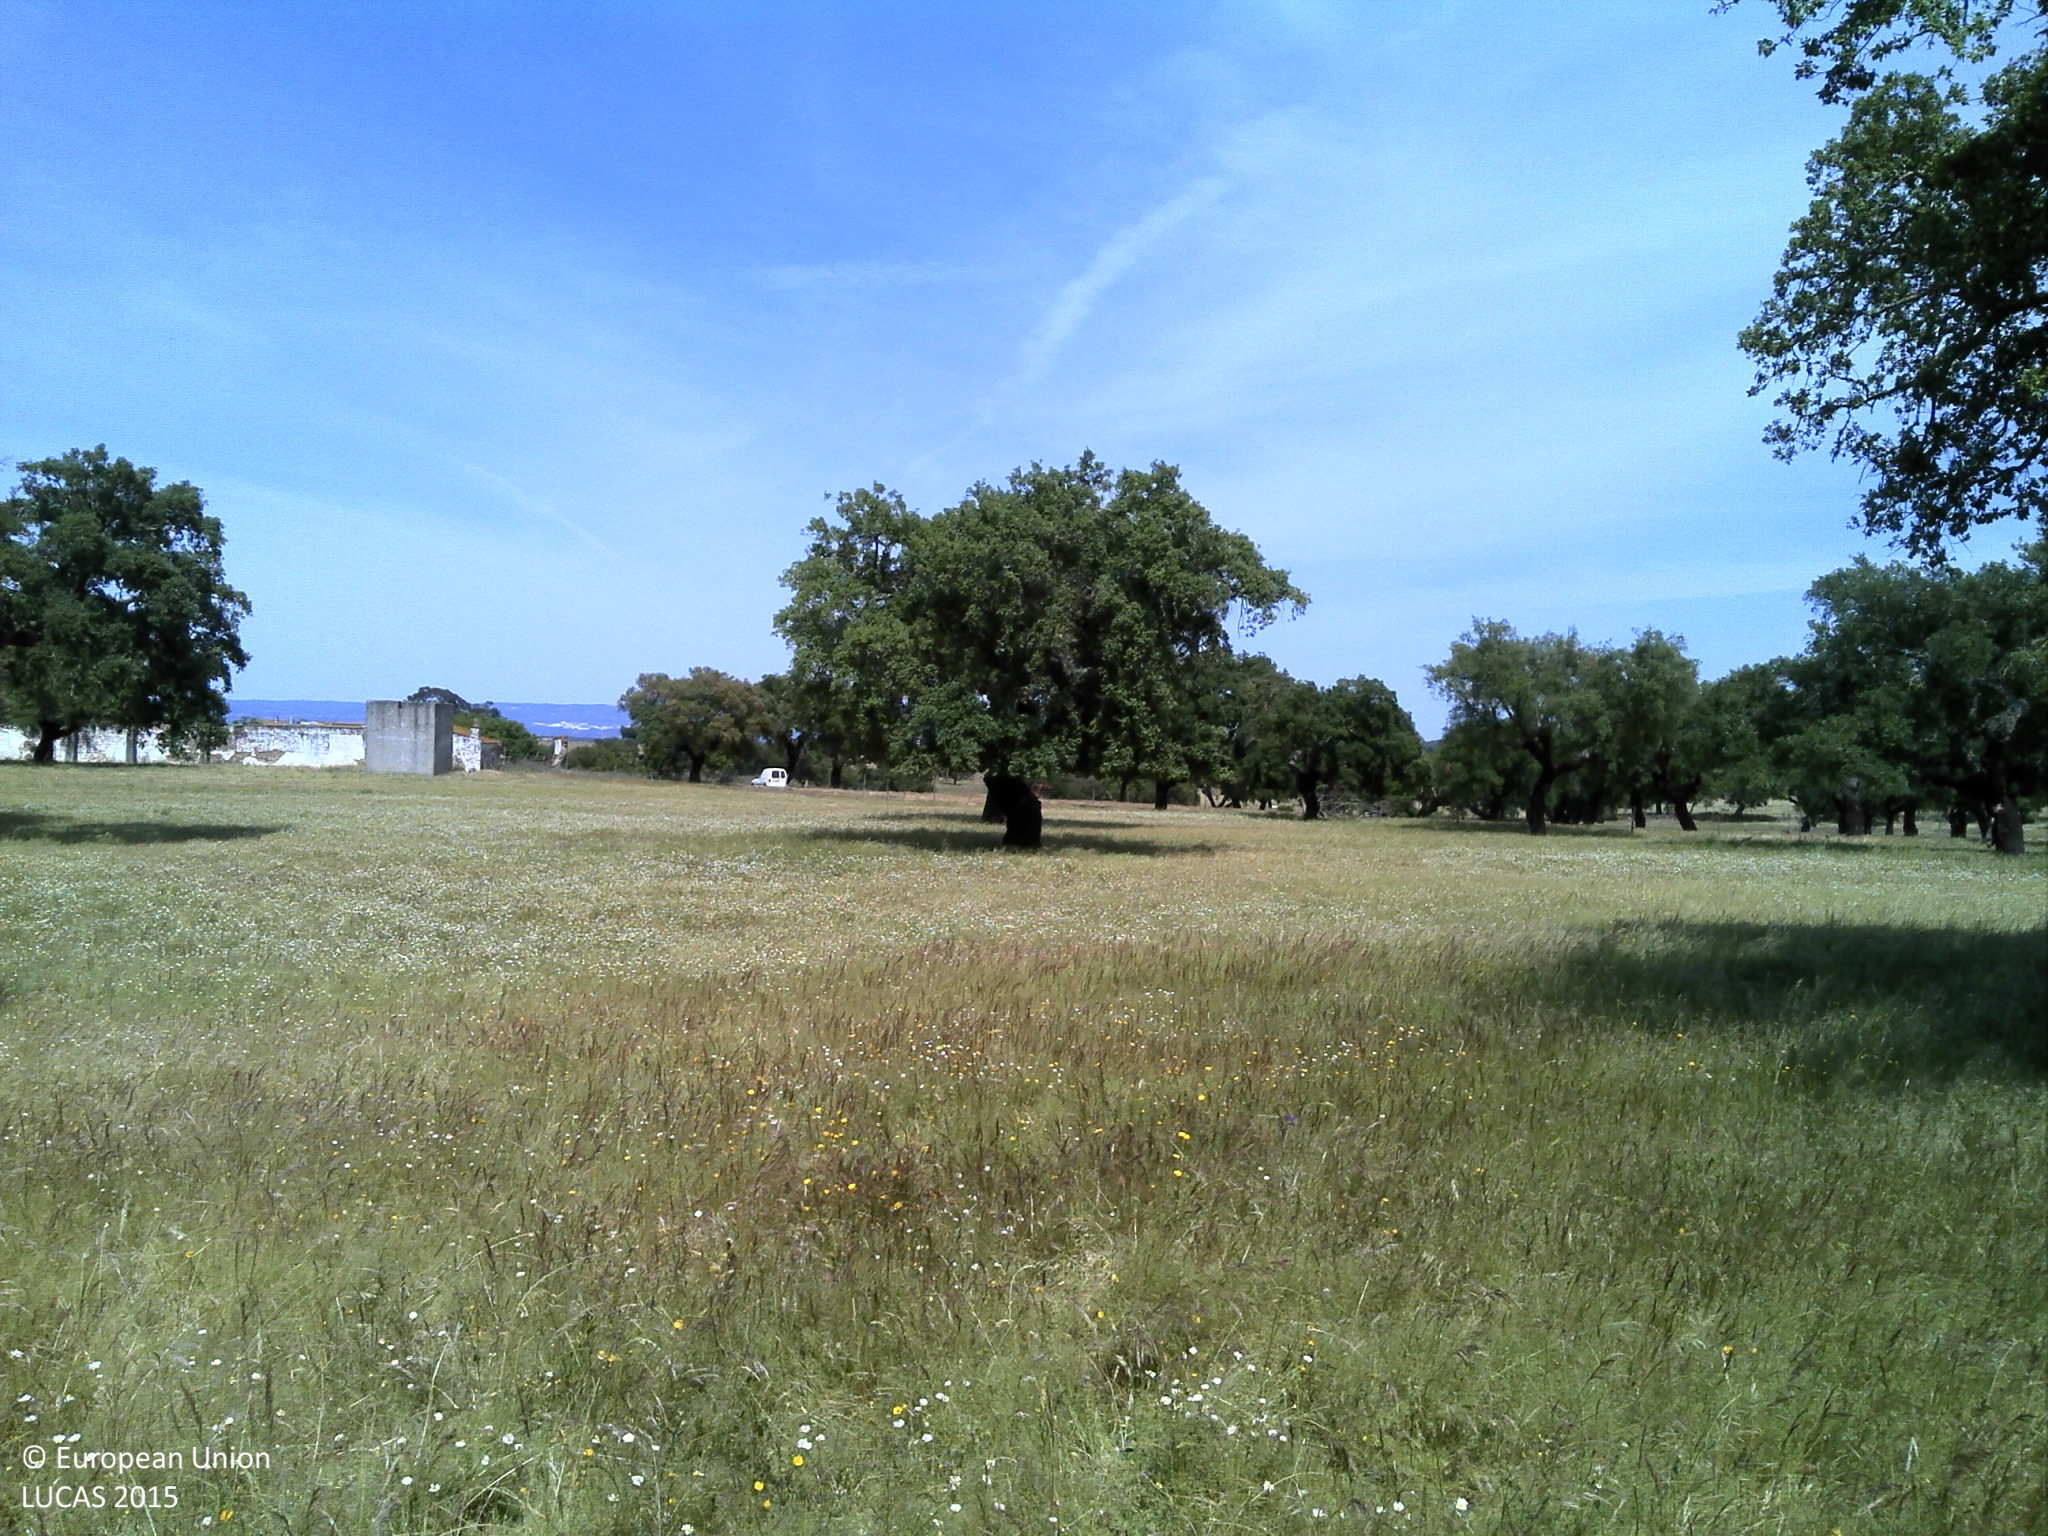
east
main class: Woodland
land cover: Broadleaved woodland
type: broadleaved evergreen forest
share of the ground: 25 - 50 %
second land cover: Grassland without tree/shrub cover
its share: 50 - 75 %
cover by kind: herbaceous plants 50 %, broadleaved forest trees 40 %, unconsolidated bare surface 10 %
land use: Forestry
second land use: Agriculture (excluding fallow land and kitchen gardens)
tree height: > 5 m
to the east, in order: Broadleaved woodland; Grassland without tree/shrub cover; Broadleaved woodland; Fences; Tracks; Broadleaved woodland; Grassland without tree/shrub cover; Broadleaved woodland; Grassland without tree/shrub cover; Broadleaved woodland
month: May
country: PT
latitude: 39.2094
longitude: -7.6362
